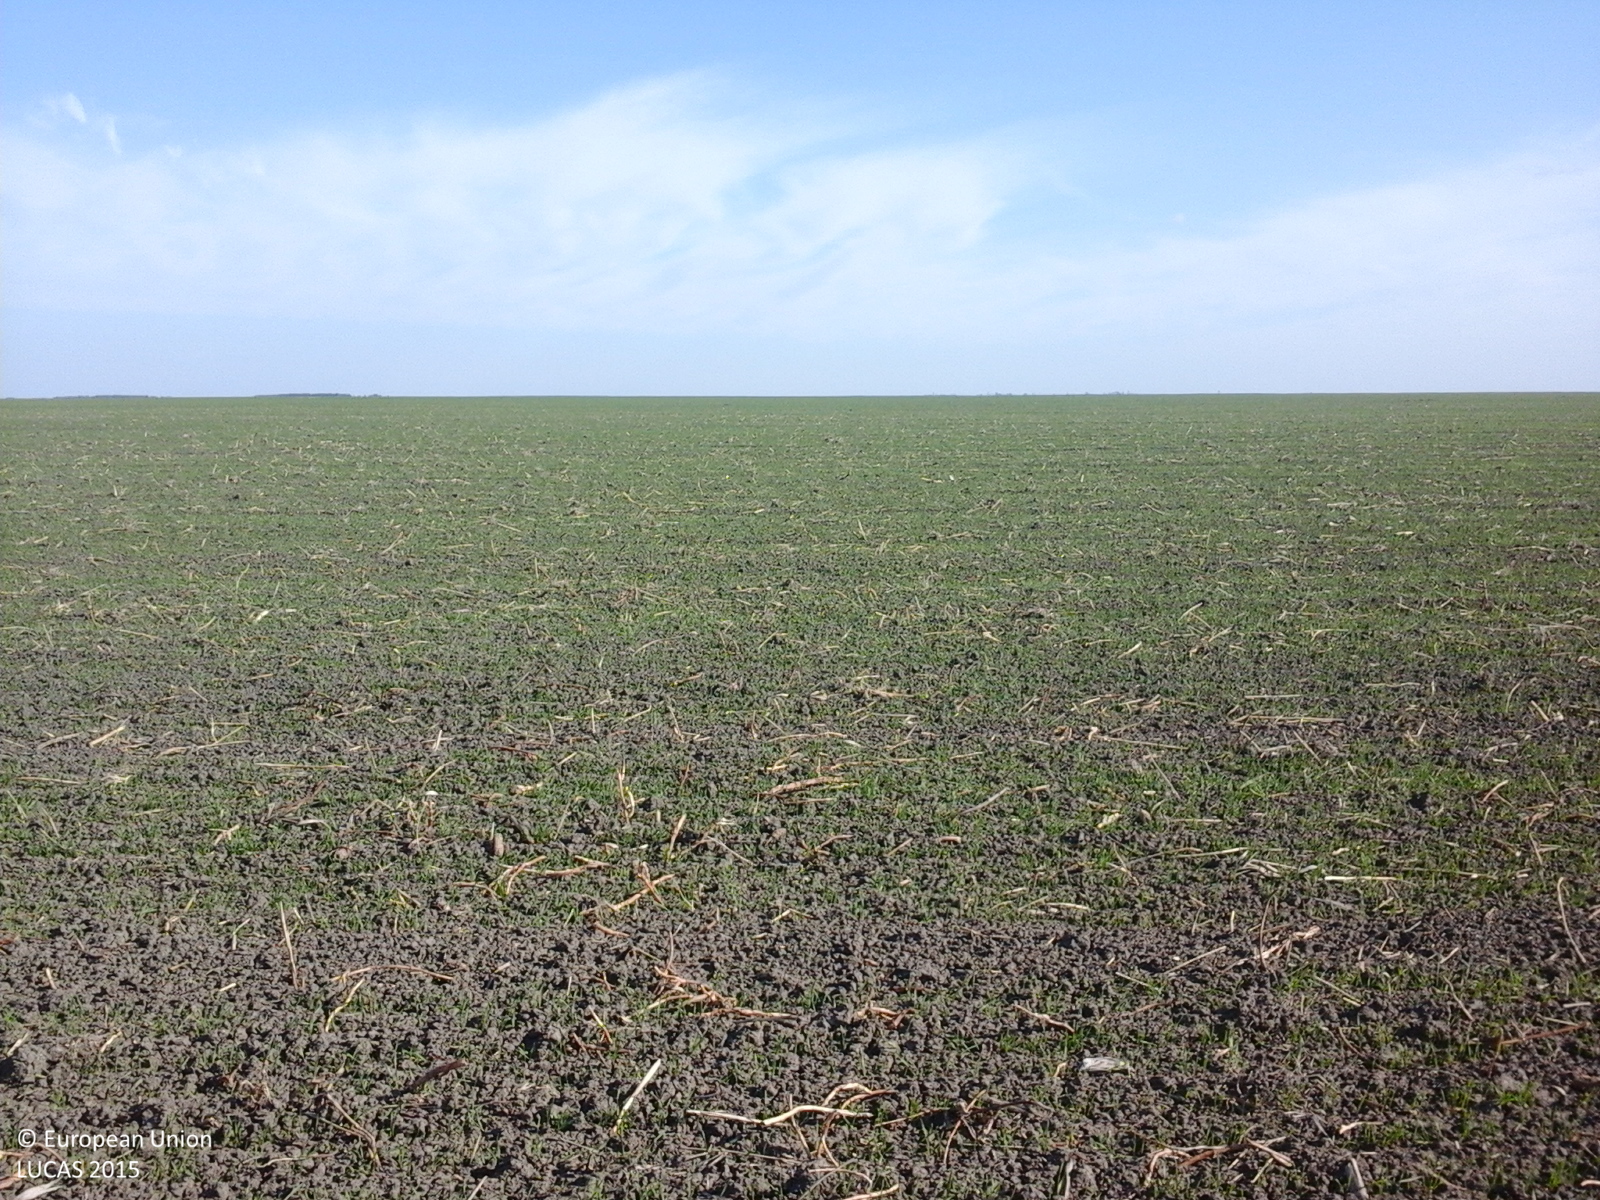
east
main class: Cropland
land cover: Common wheat
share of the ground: 25 - 50 %
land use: Agriculture (excluding fallow land and kitchen gardens)
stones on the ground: < 10 %
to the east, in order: Common wheat
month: October
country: RO
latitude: 45.4145
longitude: 27.3610
